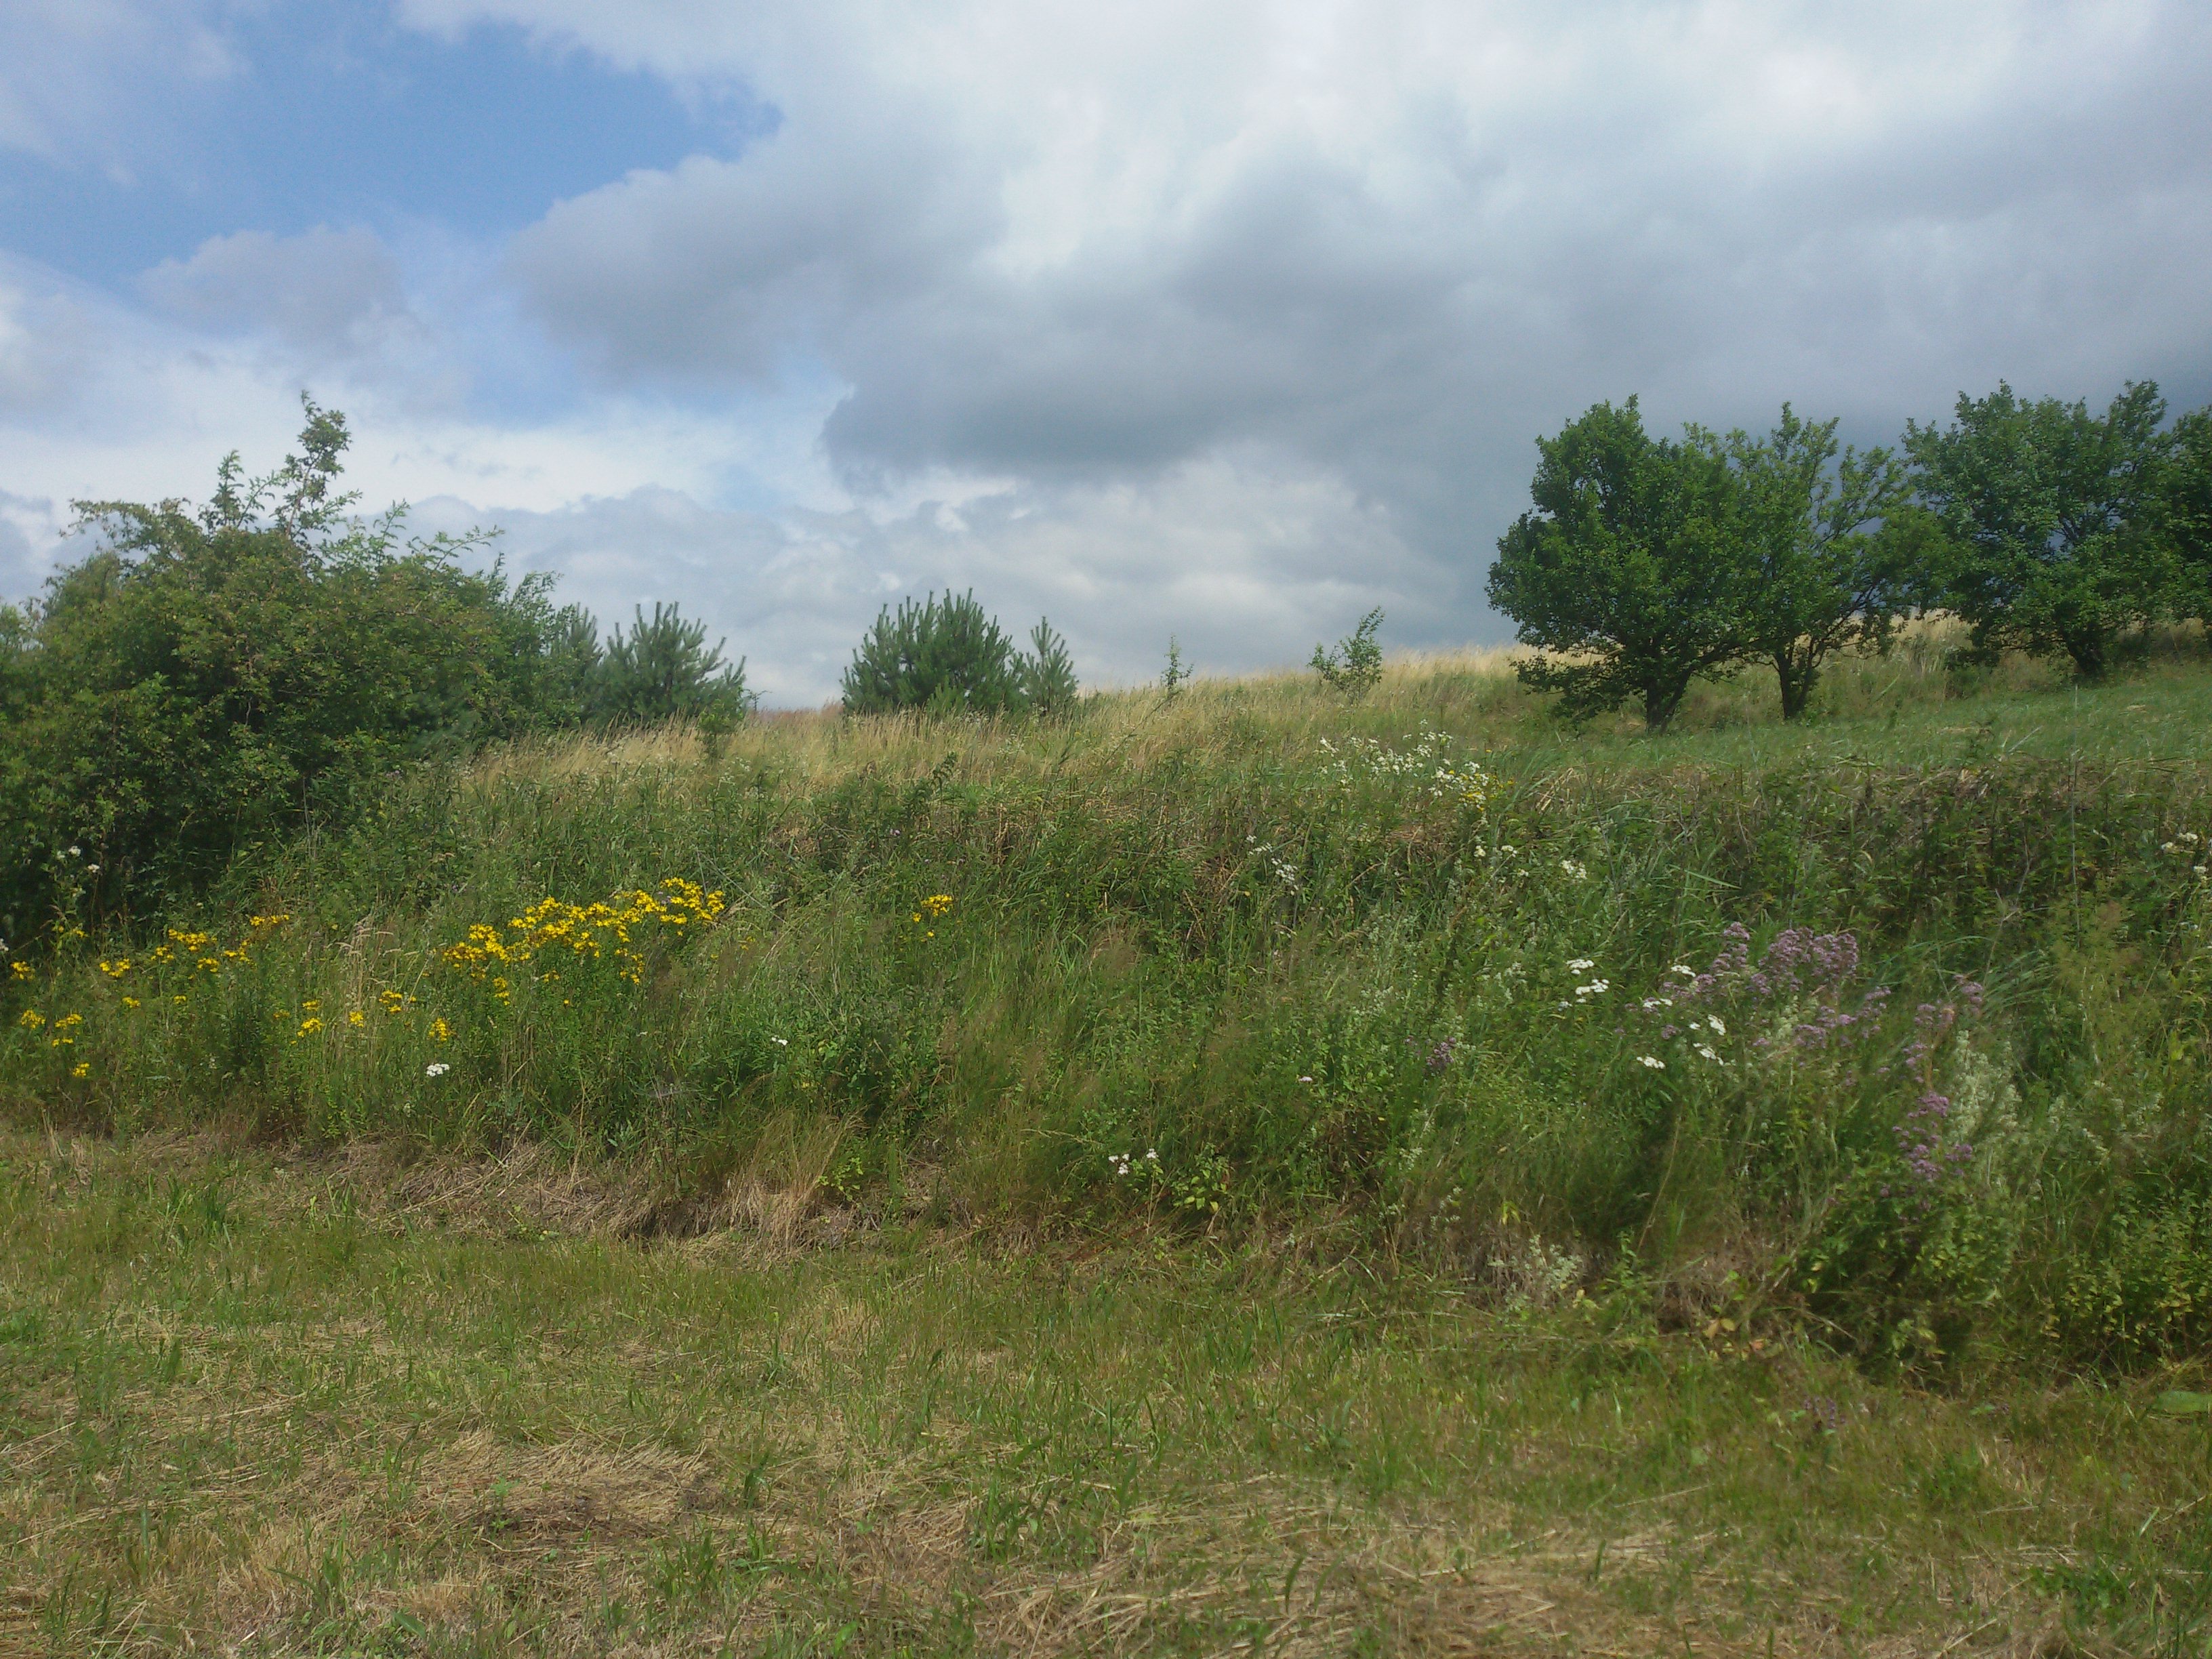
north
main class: Grassland
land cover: Grassland without tree/shrub cover
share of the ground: > 75 %
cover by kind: herbaceous plants 100 %
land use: Agriculture (excluding fallow land and kitchen gardens)
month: July
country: PL
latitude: 49.7735
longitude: 22.2667
